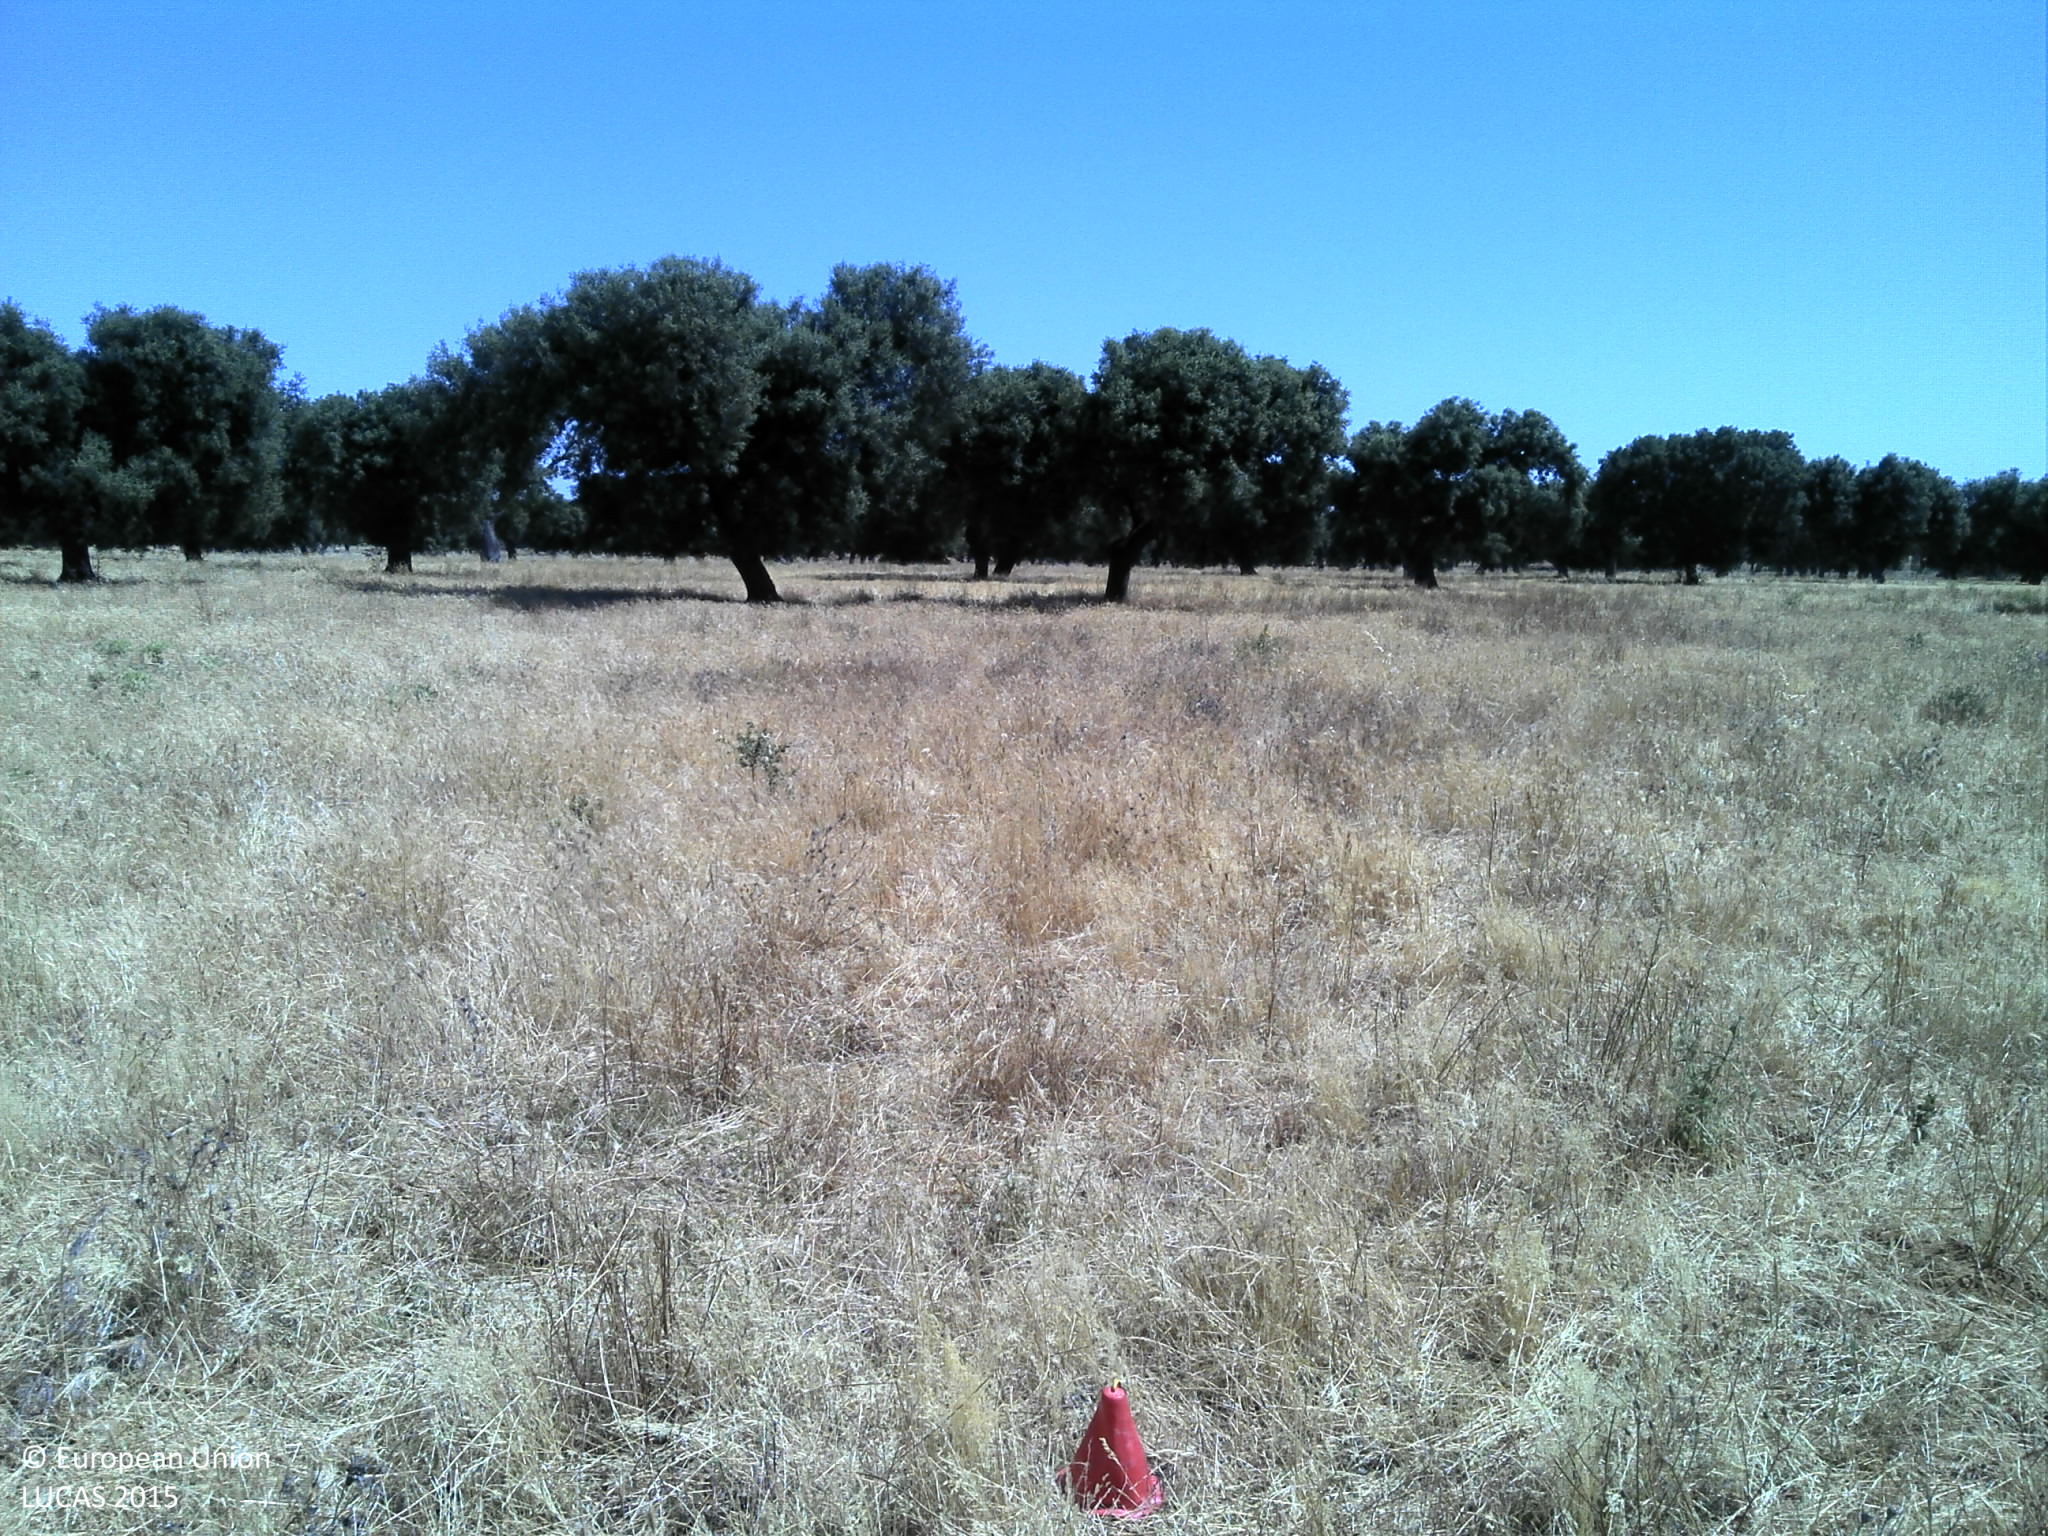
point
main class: Woodland
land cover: Broadleaved woodland
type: broadleaved evergreen forest
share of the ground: 10 - 25 %
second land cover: Grassland without tree/shrub cover
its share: 50 - 75 %
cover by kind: herbaceous plants 70 %, unconsolidated bare surface 20 %, broadleaved forest trees 10 %
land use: Forestry
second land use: Agriculture (excluding fallow land and kitchen gardens)
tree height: > 5 m
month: May
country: PT
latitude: 39.0077
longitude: -7.6285
